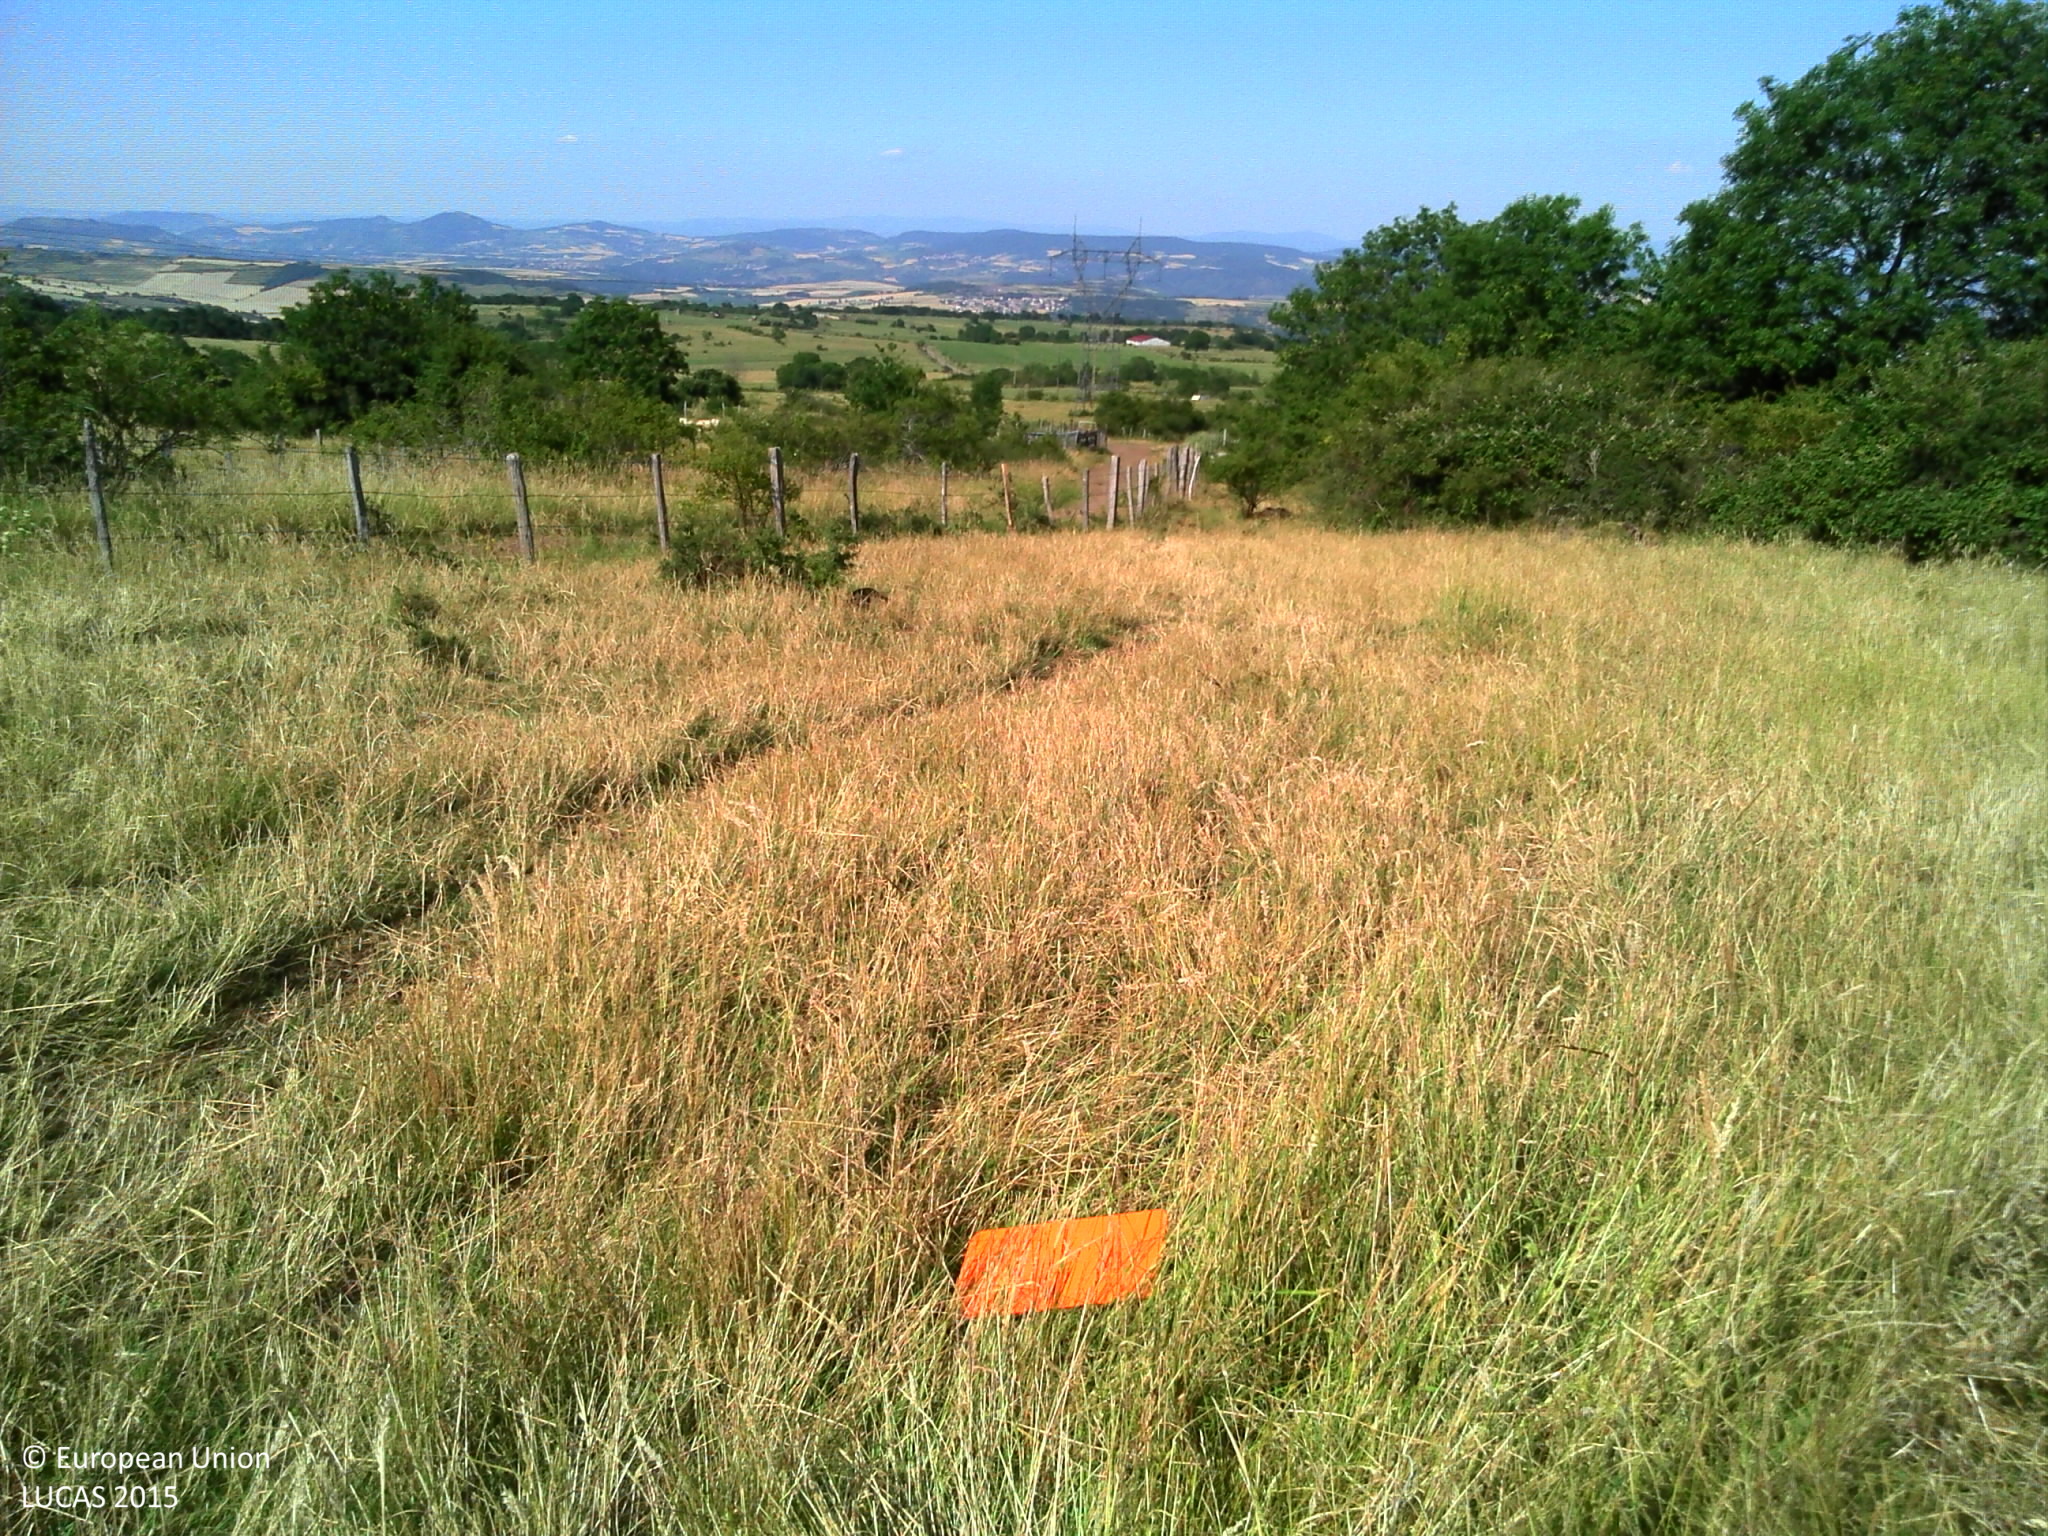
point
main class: Grassland
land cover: Grassland without tree/shrub cover
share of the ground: > 75 %
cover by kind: herbaceous plants 100 %
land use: Agriculture (excluding fallow land and kitchen gardens)
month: June
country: FR
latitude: 45.5137
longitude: 3.1010
